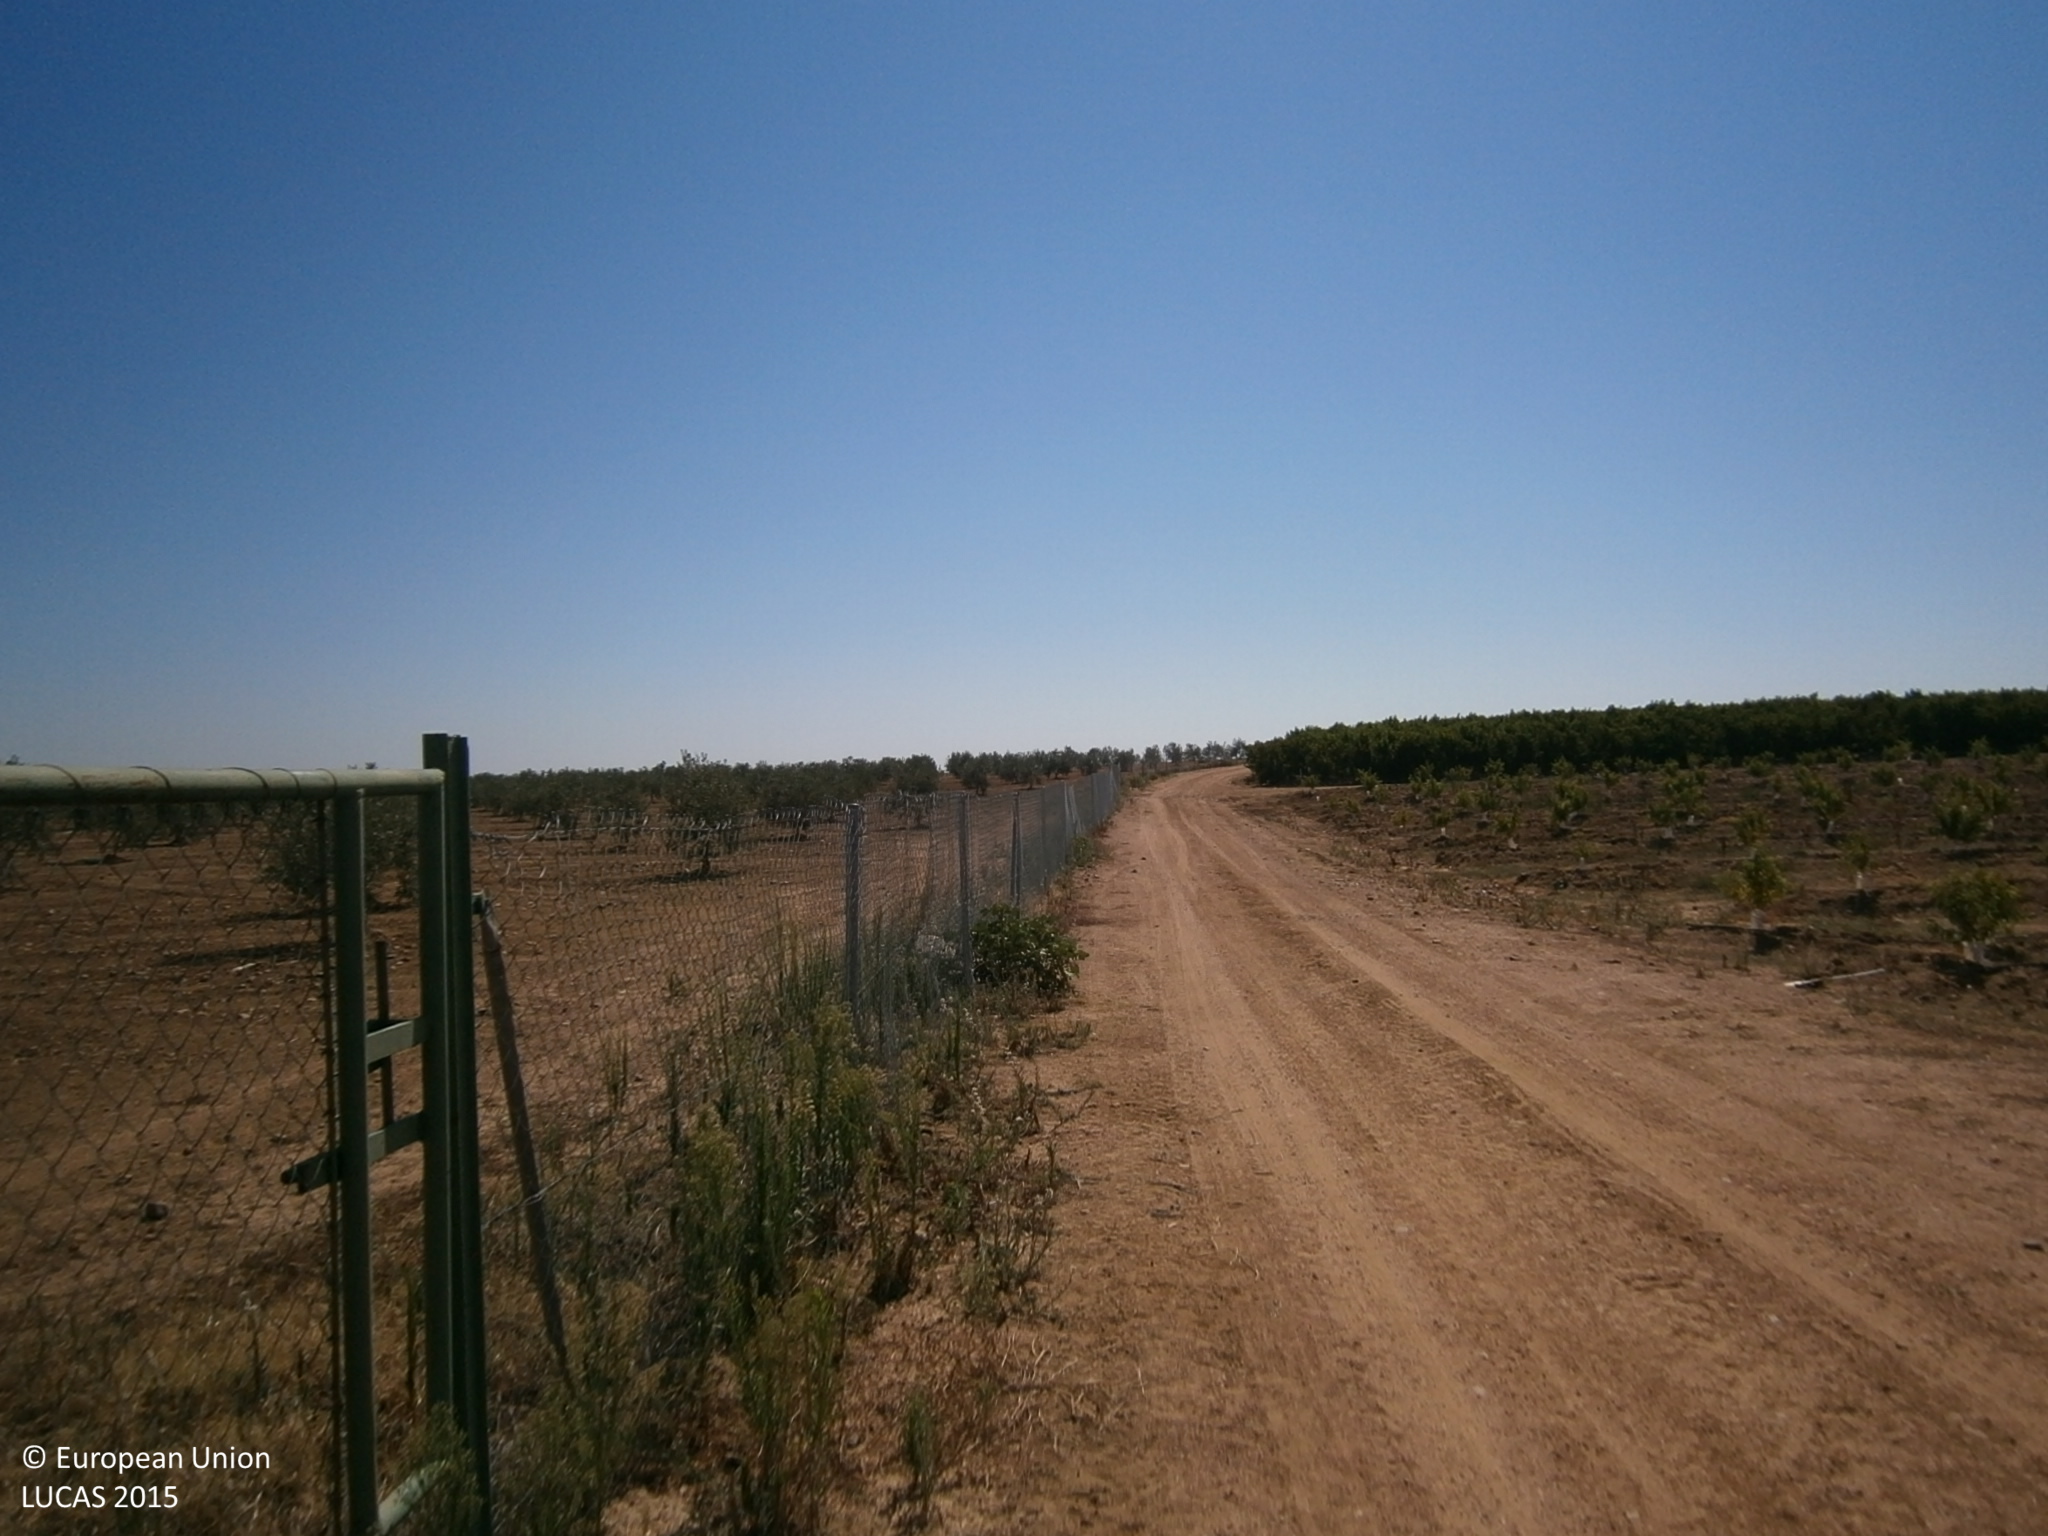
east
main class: Cropland
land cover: Olive groves
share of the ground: 25 - 50 %
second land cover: Other bare soil
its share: > 75 %
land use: Agriculture (excluding fallow land and kitchen gardens)
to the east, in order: Olive groves; Other bare soil
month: July
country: ES
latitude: 38.9622
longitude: -6.8605
